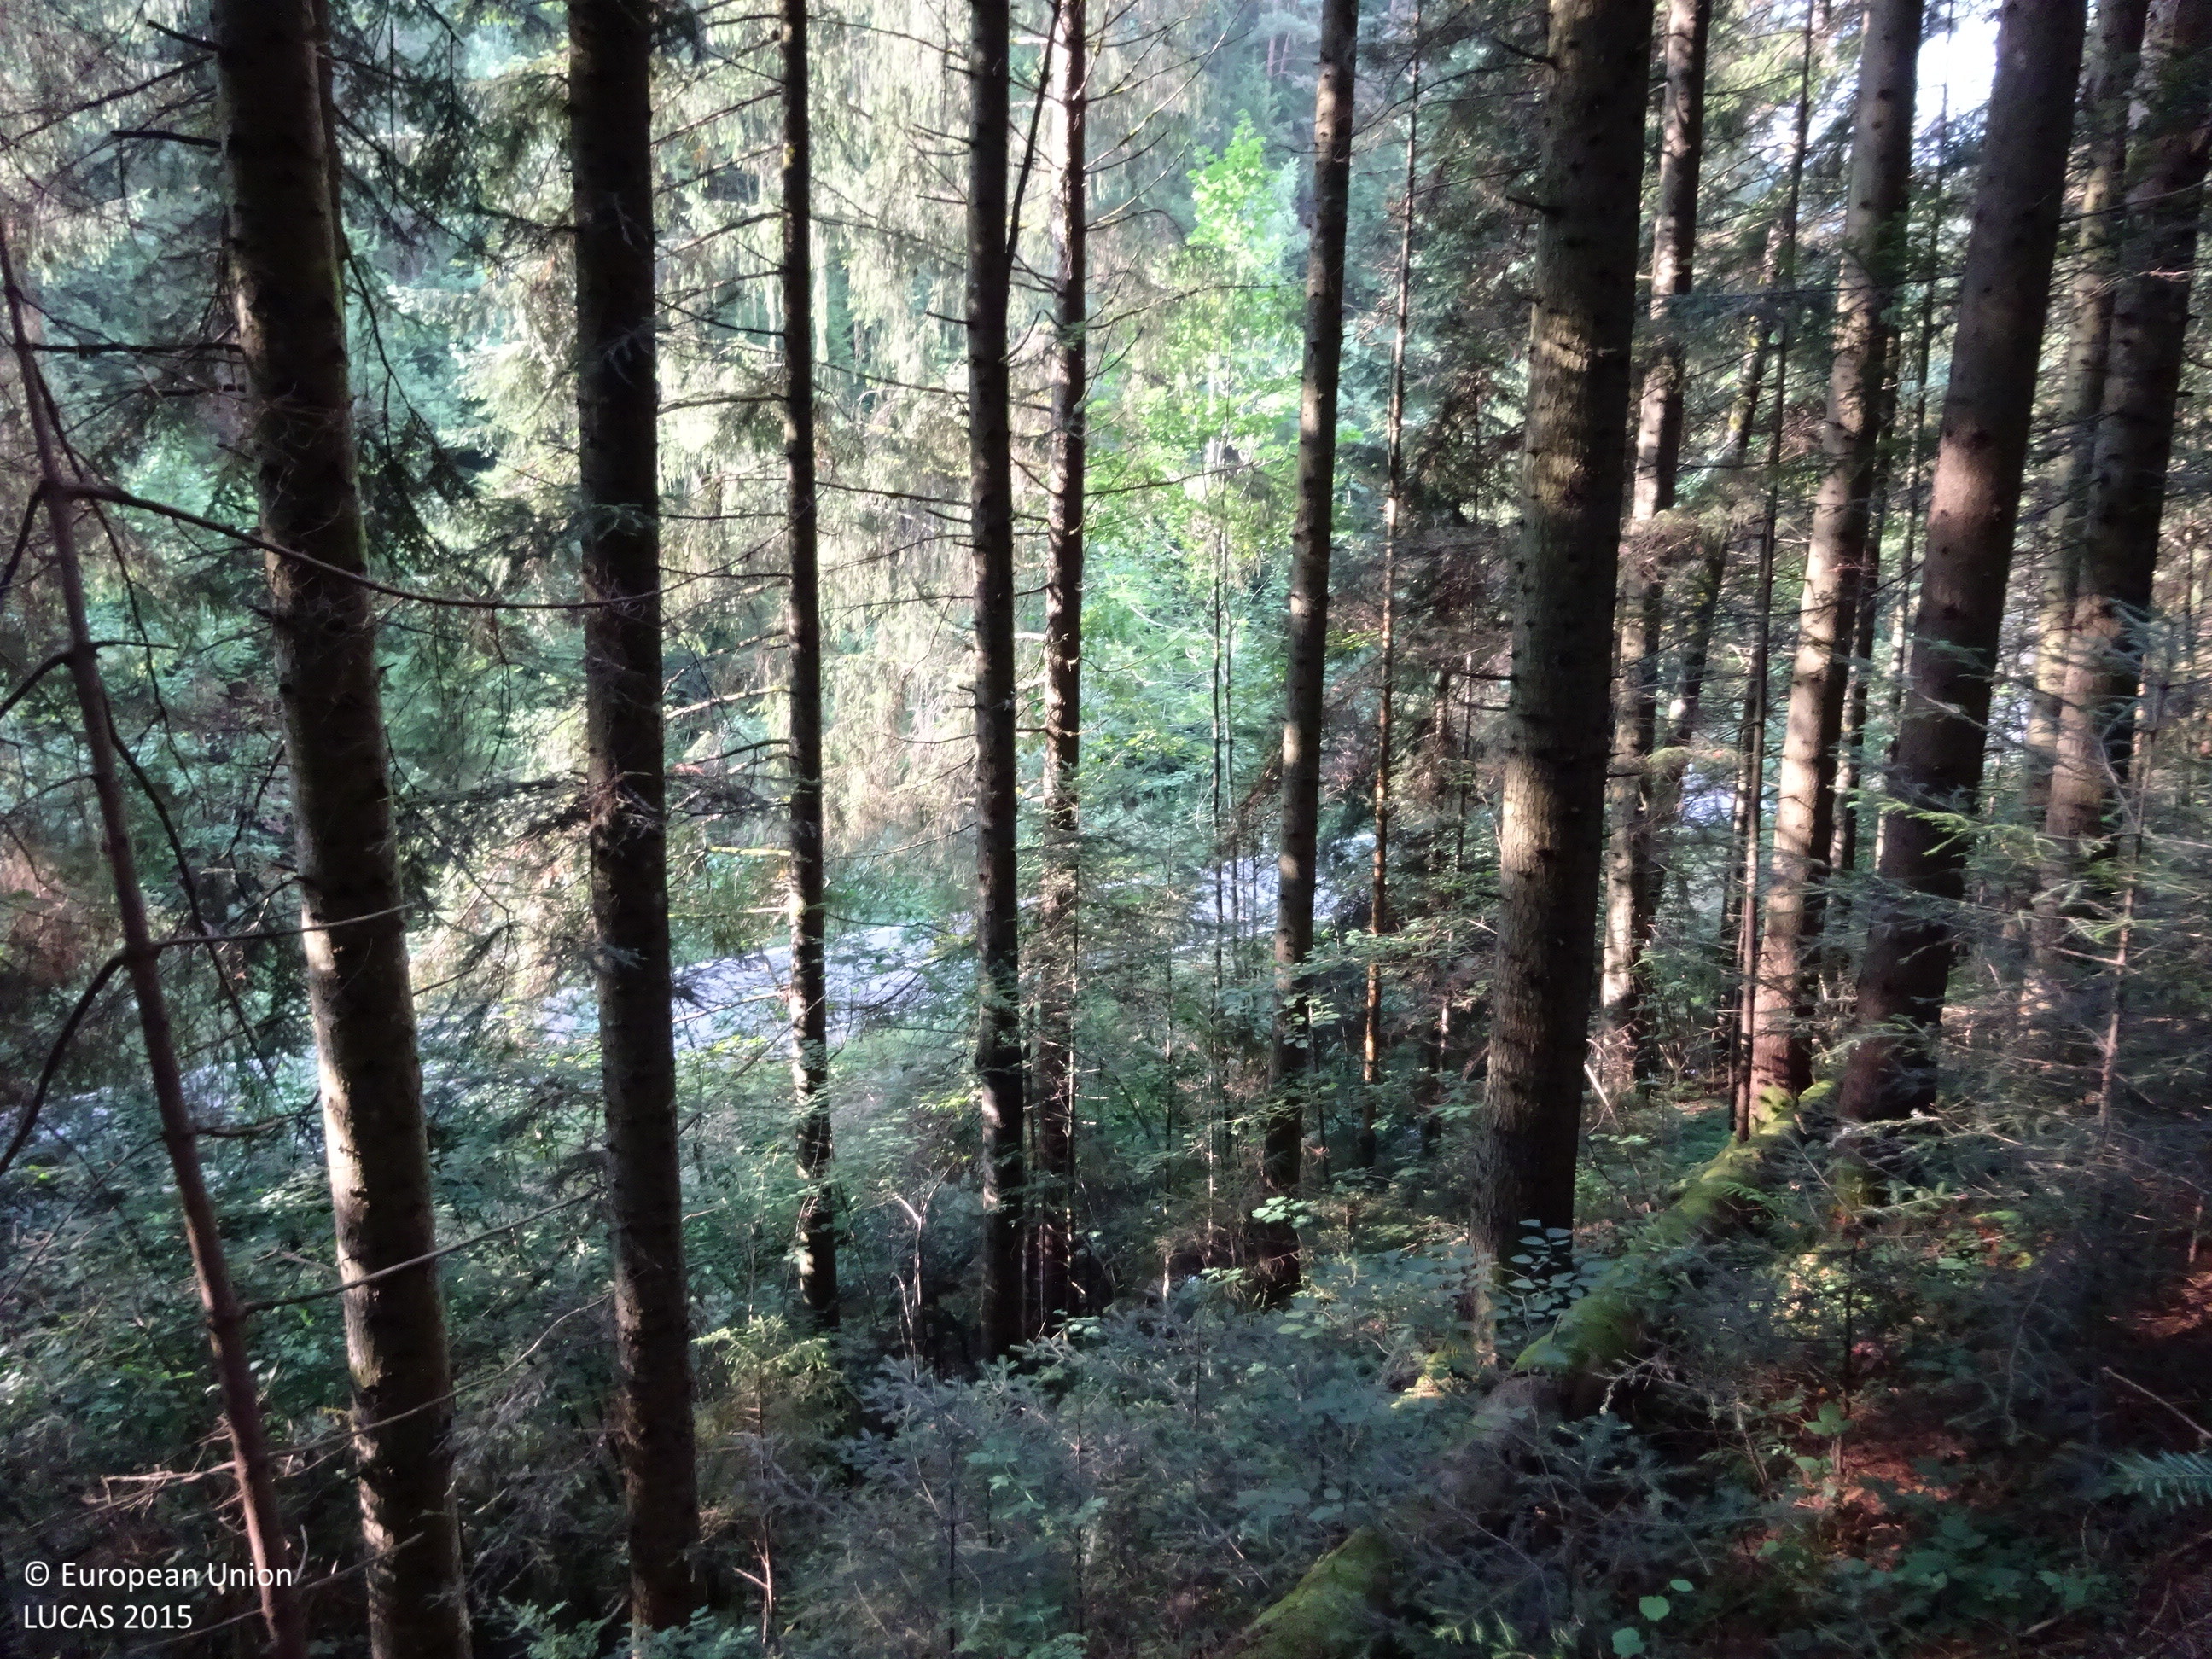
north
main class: Woodland
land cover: Spruce dominated coniferous woodland
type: alpine coniferous forest
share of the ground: > 75 %
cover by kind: coniferous forest trees 100 %
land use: Forestry
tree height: > 5 m
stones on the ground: < 10 %
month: August
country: AT
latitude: 47.3541
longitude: 15.7070
